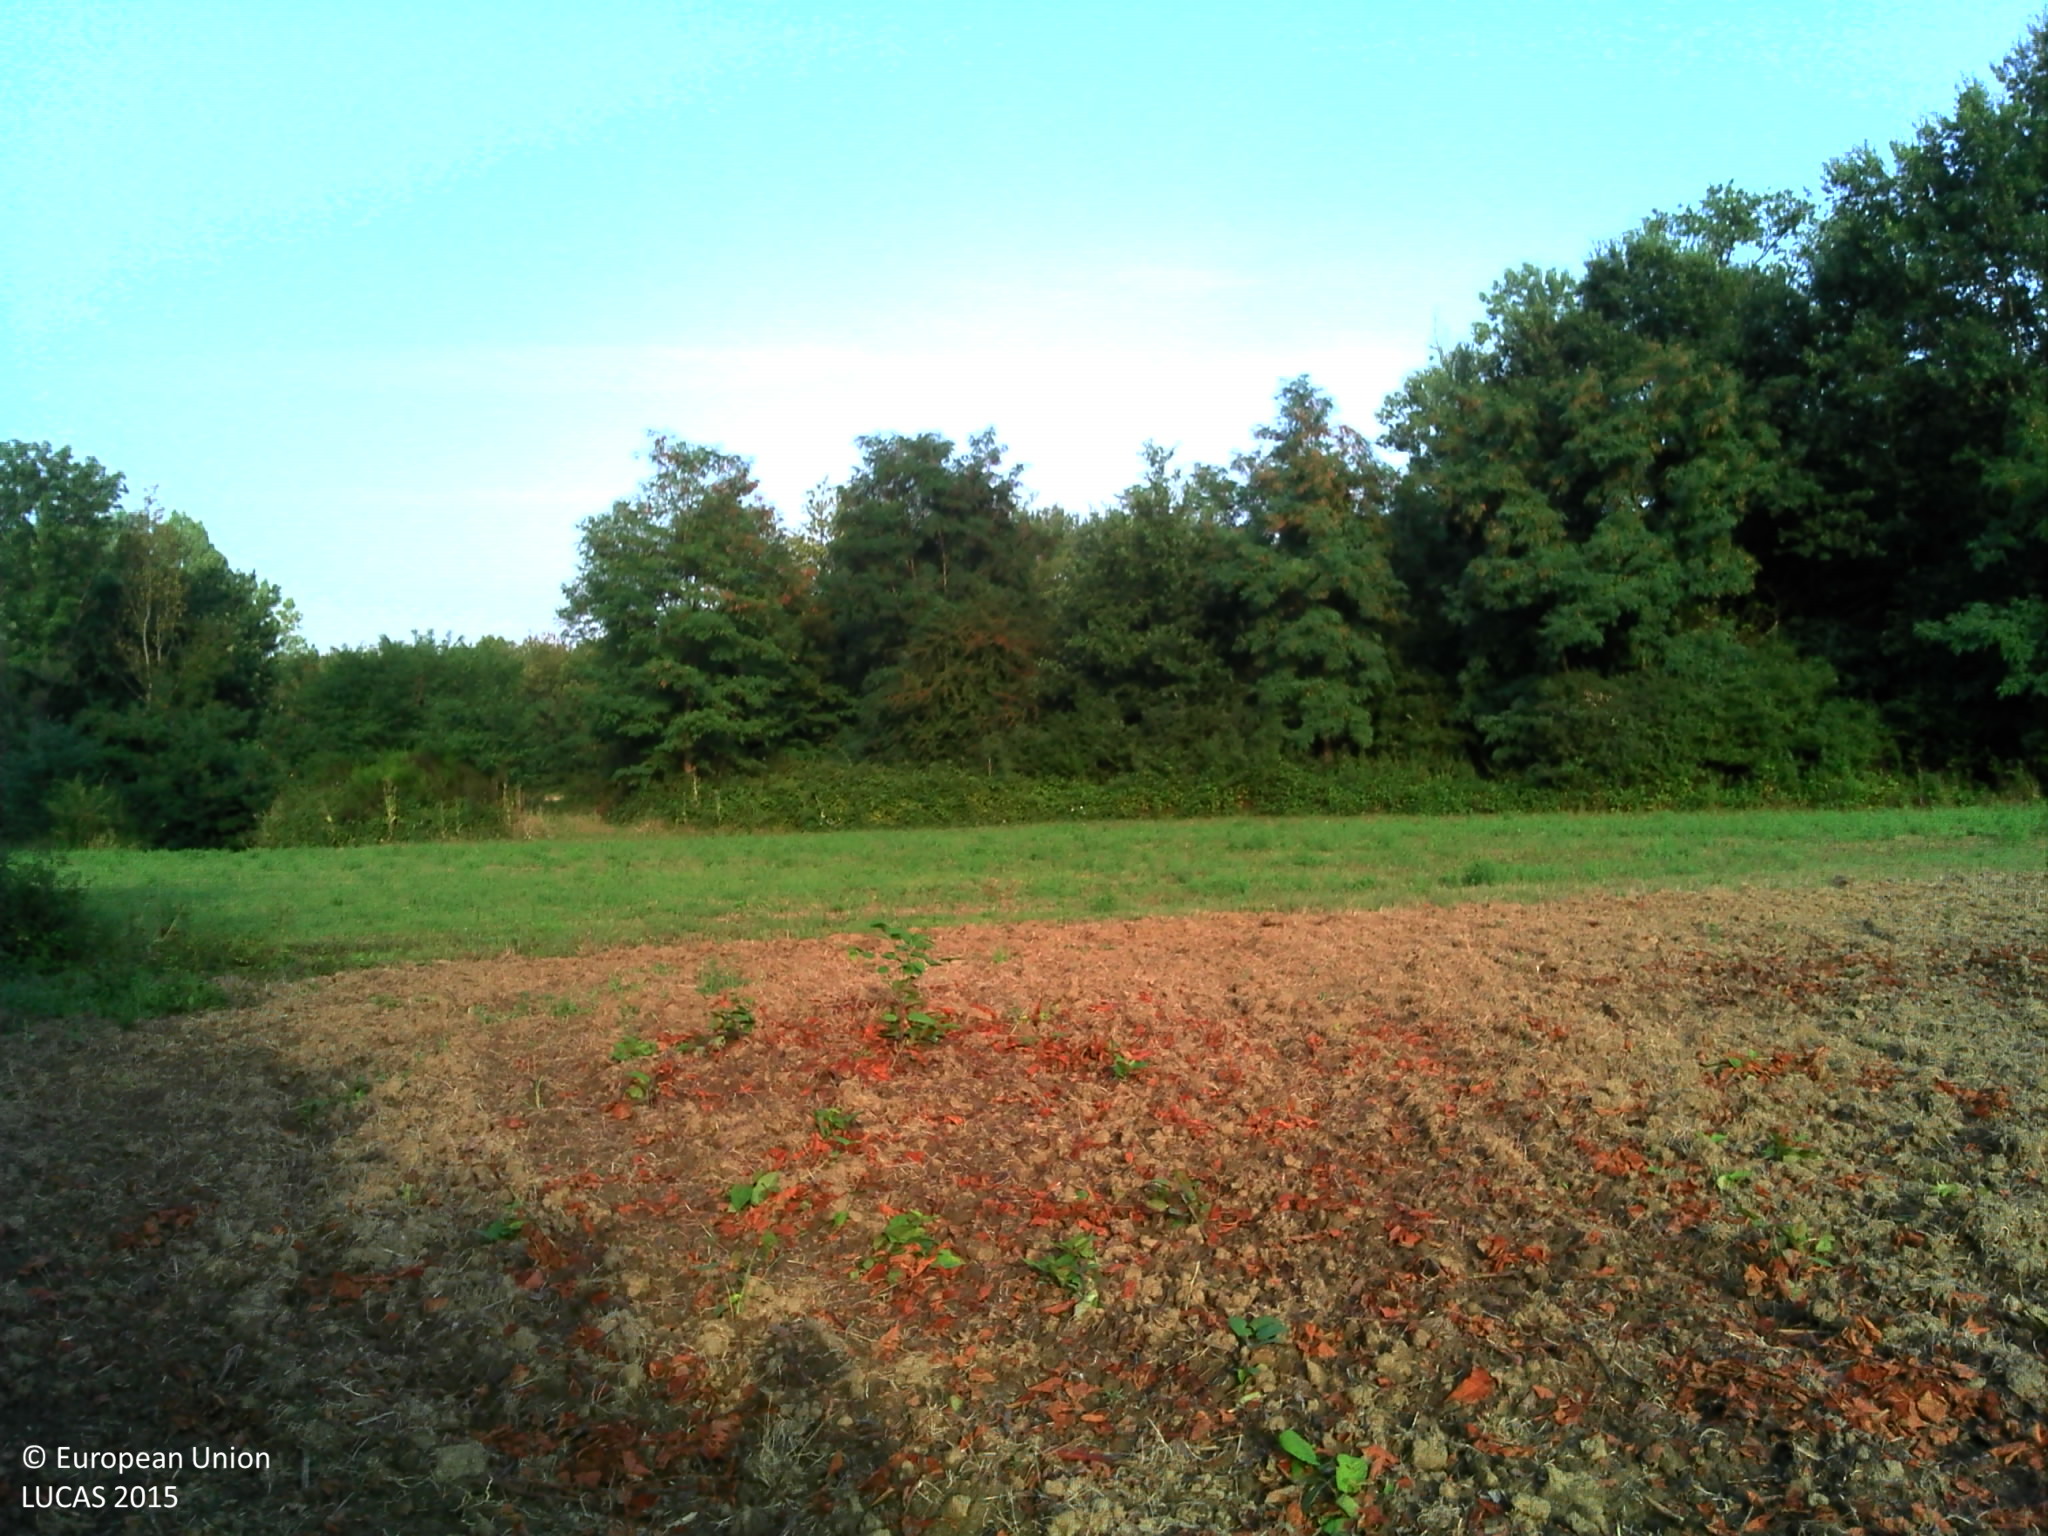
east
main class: Woodland
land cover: Broadleaved woodland
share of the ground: > 75 %
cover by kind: broadleaved forest trees 80 %, herbaceous plants 10 %, unconsolidated bare surface 10 %
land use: Semi-natural and natural areas not in use
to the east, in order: Broadleaved woodland; Other bare soil; Grassland without tree/shrub cover; Broadleaved woodland; Rivers and streams; Tracks; Other bare soil; Broadleaved woodland
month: August
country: FR
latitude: 45.6472
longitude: 4.1133
